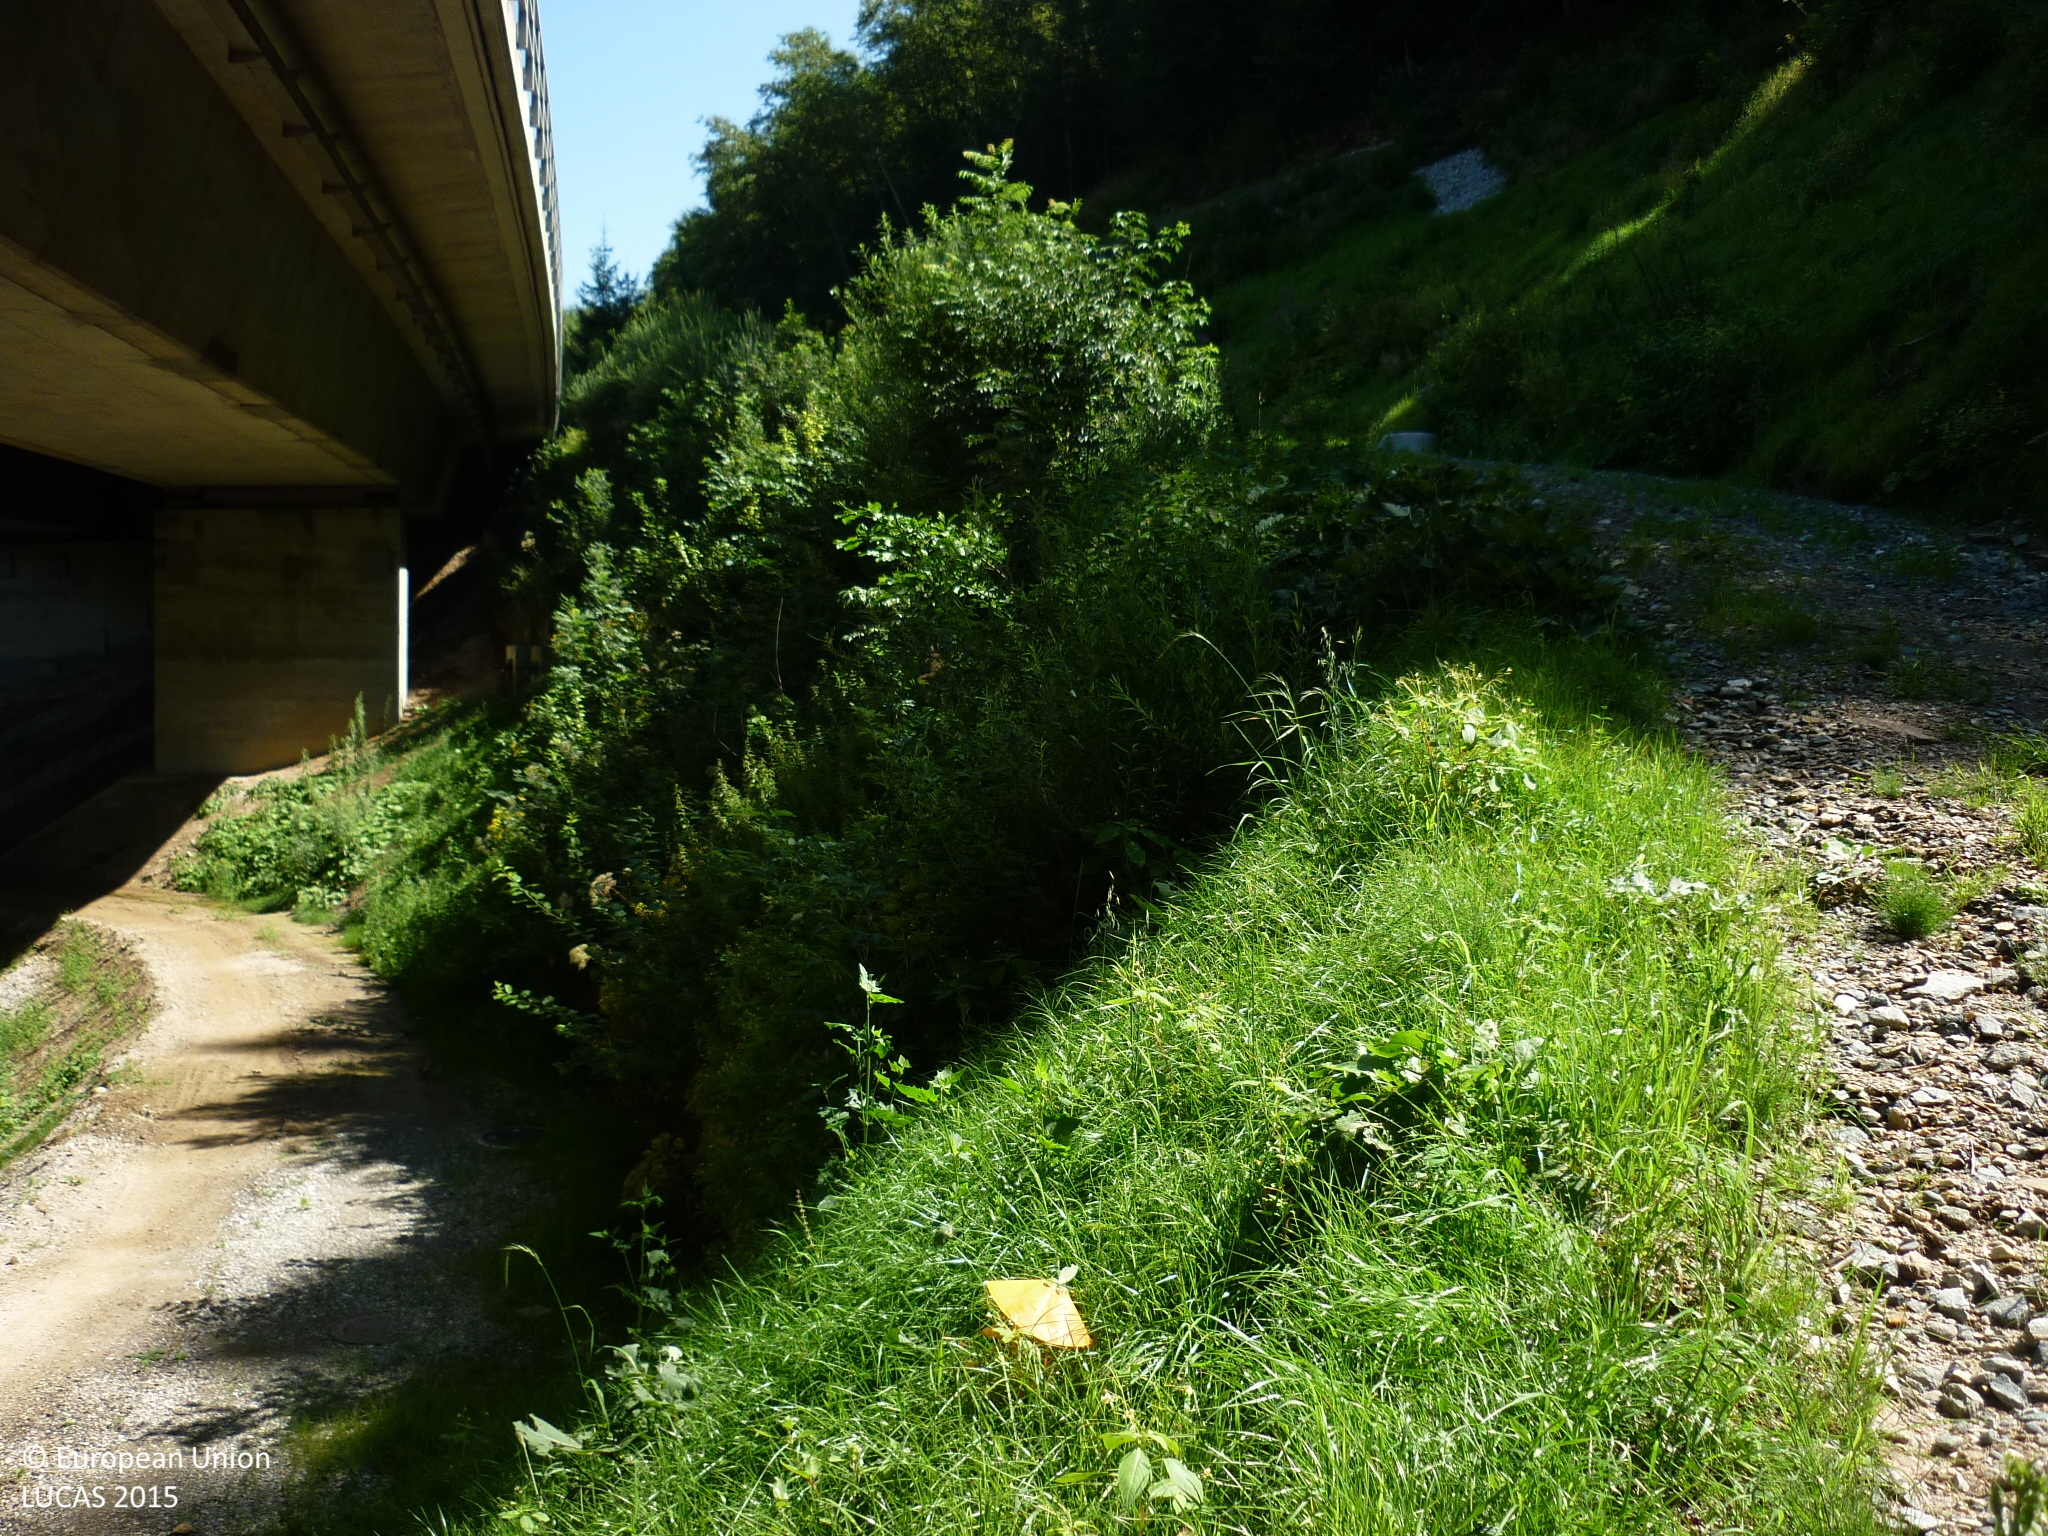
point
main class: Grassland
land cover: Grassland without tree/shrub cover
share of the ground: > 75 %
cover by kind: herbaceous plants 100 %
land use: Road transport
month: August
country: AT
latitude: 46.9222
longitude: 13.5827
